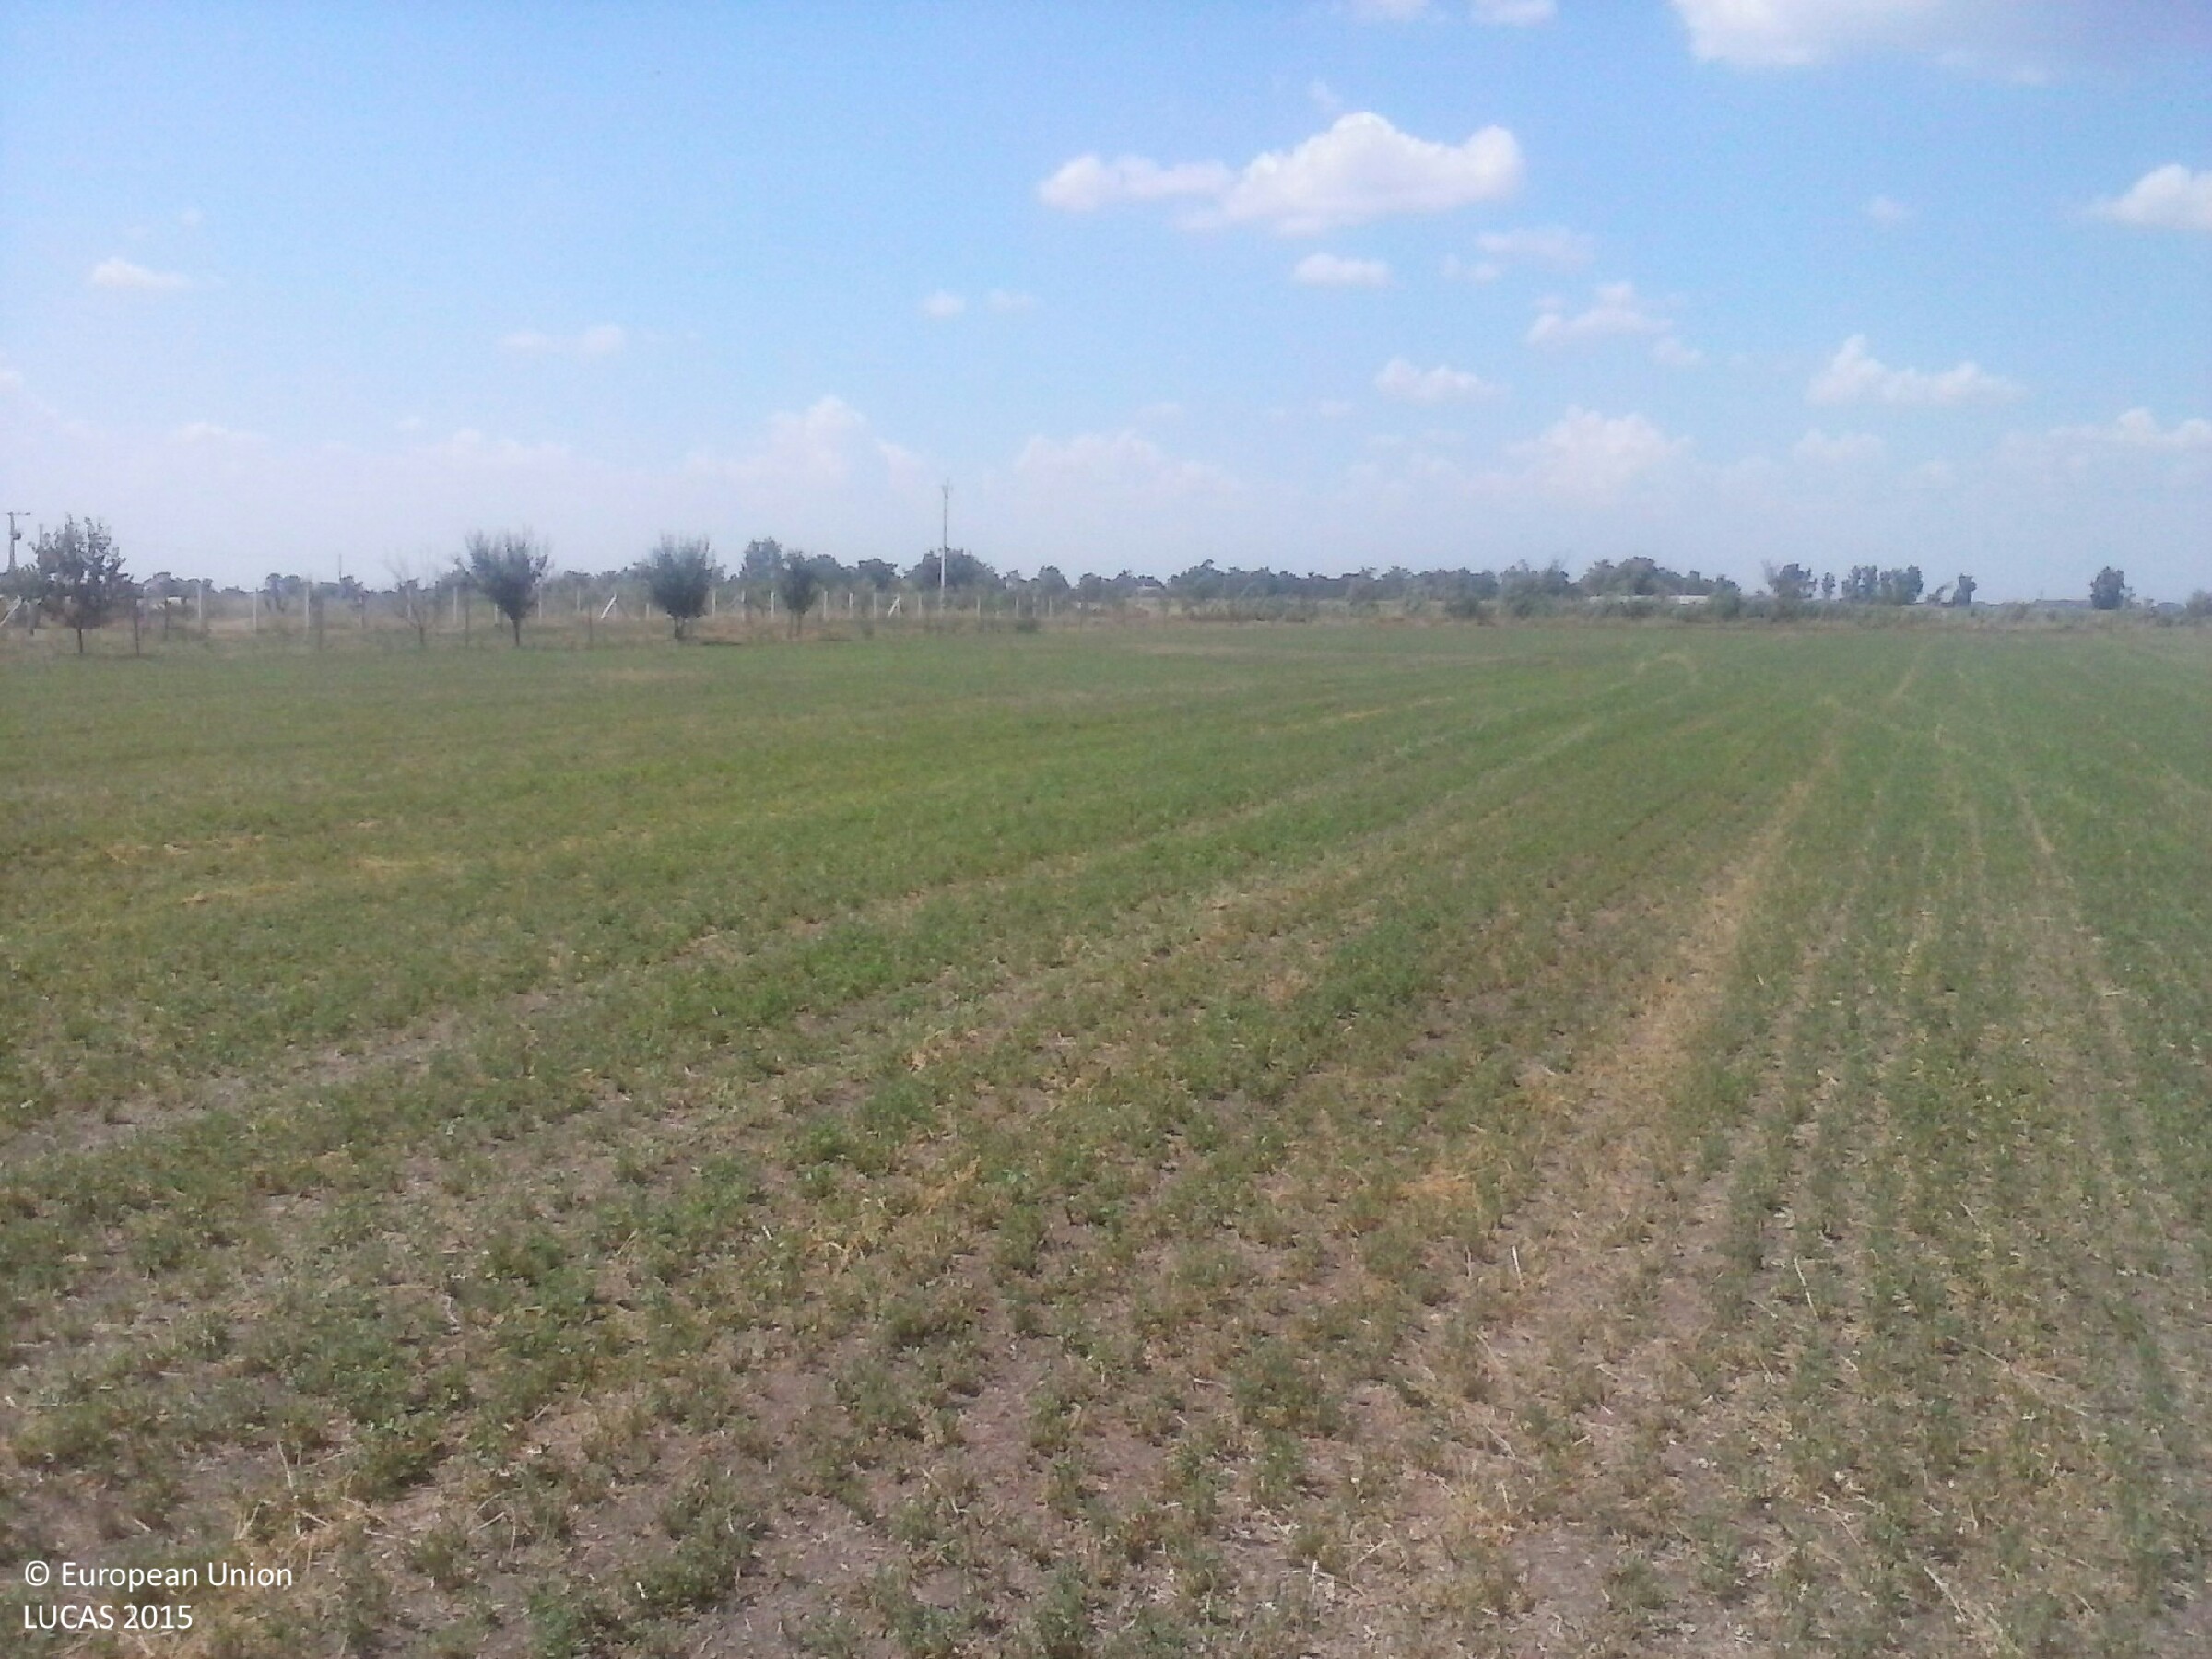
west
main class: Cropland
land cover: Lucerne
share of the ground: > 75 %
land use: Agriculture (excluding fallow land and kitchen gardens)
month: July
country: HU
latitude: 46.6880
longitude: 20.1046
